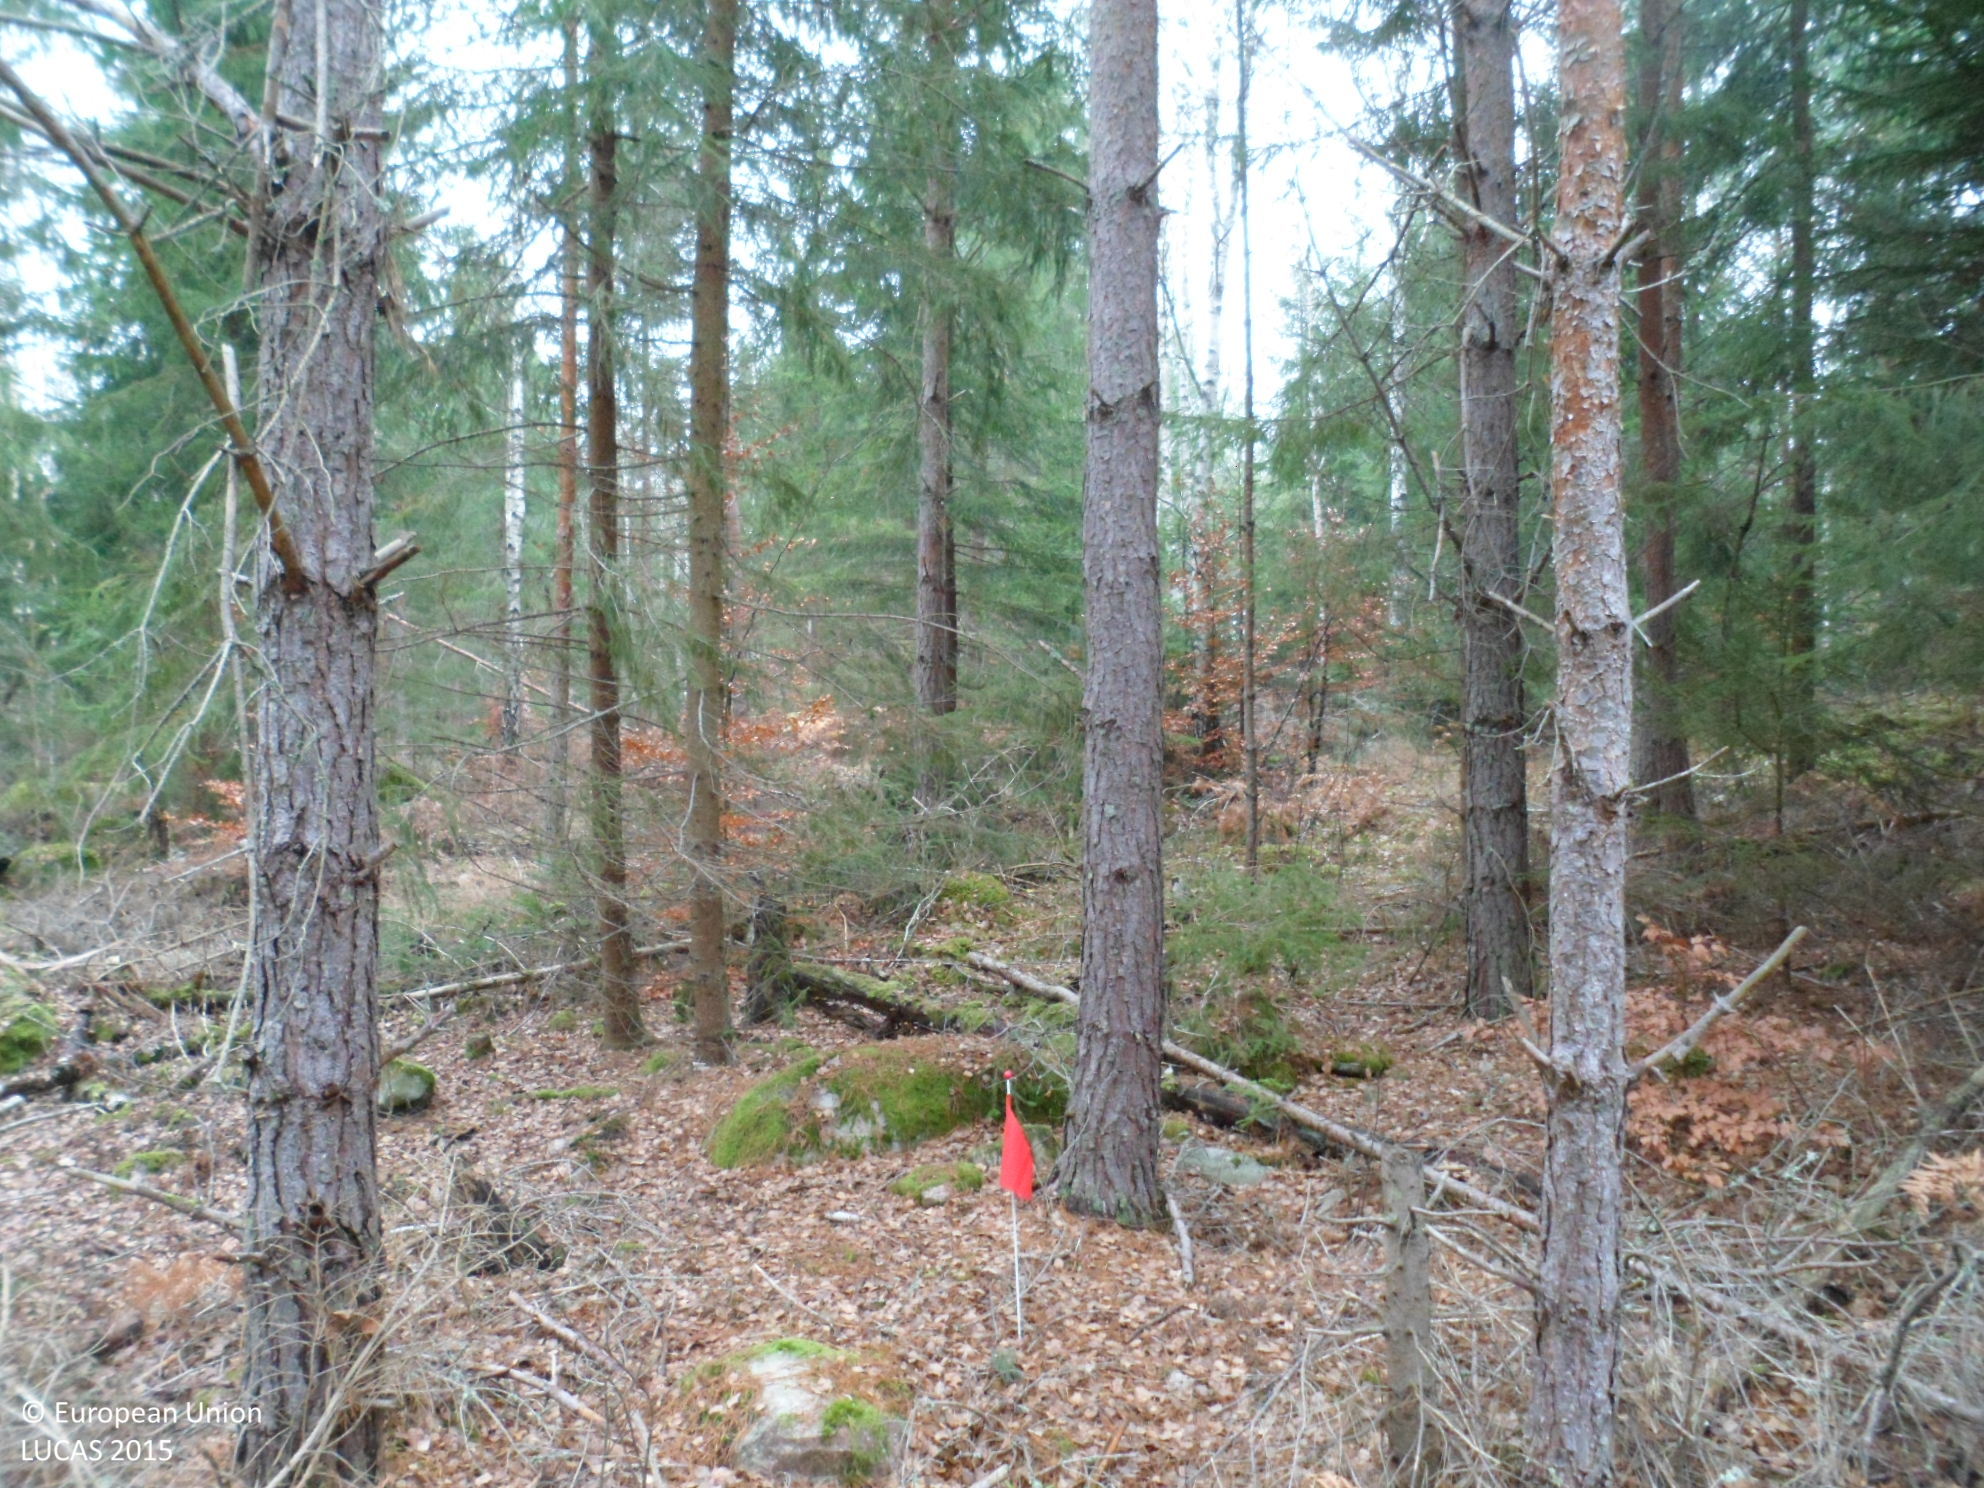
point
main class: Woodland
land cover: Pine dominated coniferous woodland
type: boreal forest
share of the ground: 50 - 75 %
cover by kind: coniferous forest trees 50 %, lichens and mosses 15 %, unconsolidated bare surface 15 %, broadleaved forest trees 10 %, shrubs 10 %
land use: Forestry
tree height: > 5 m
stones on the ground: > 50 %
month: November
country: SE
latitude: 57.0489
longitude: 16.1811
